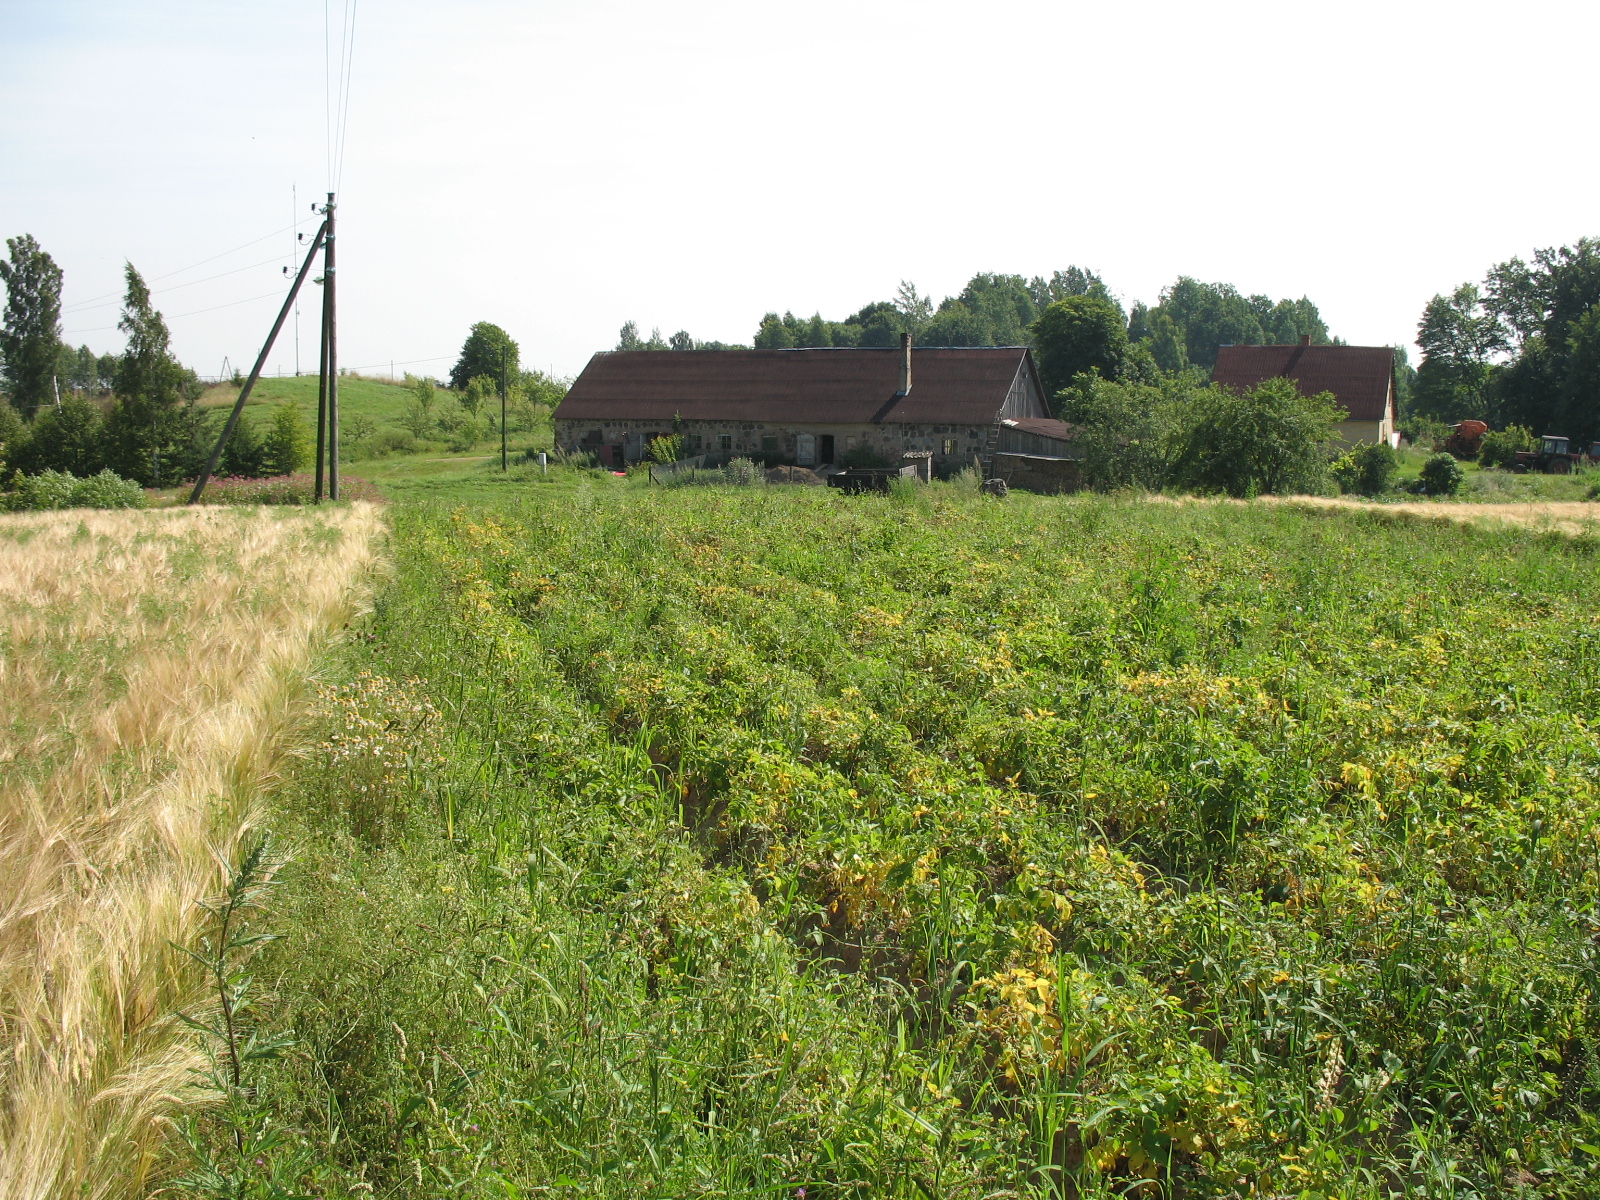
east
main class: Cropland
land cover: Barley
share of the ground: > 75 %
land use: Agriculture (excluding fallow land and kitchen gardens)
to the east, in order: Barley; Electric lines; Spontaneously vegetated surfaces; Potatoes; Barley; Grassland without tree/shrub cover; Electric lines; Grassland without tree/shrub cover; Paved roads, cycling and walking lanes; Grassland without tree/shrub cover; Apple fruit; Grassland without tree/shrub cover; Single bushes/trees; Spontaneously vegetated surfaces; Pine dominated coniferous woodland; Spontaneously vegetated surfaces; Inland marshes; Inland fresh water bodies; Inland marshes; Spontaneously vegetated surfaces
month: August
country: LV
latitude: 56.4080
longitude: 25.5334
